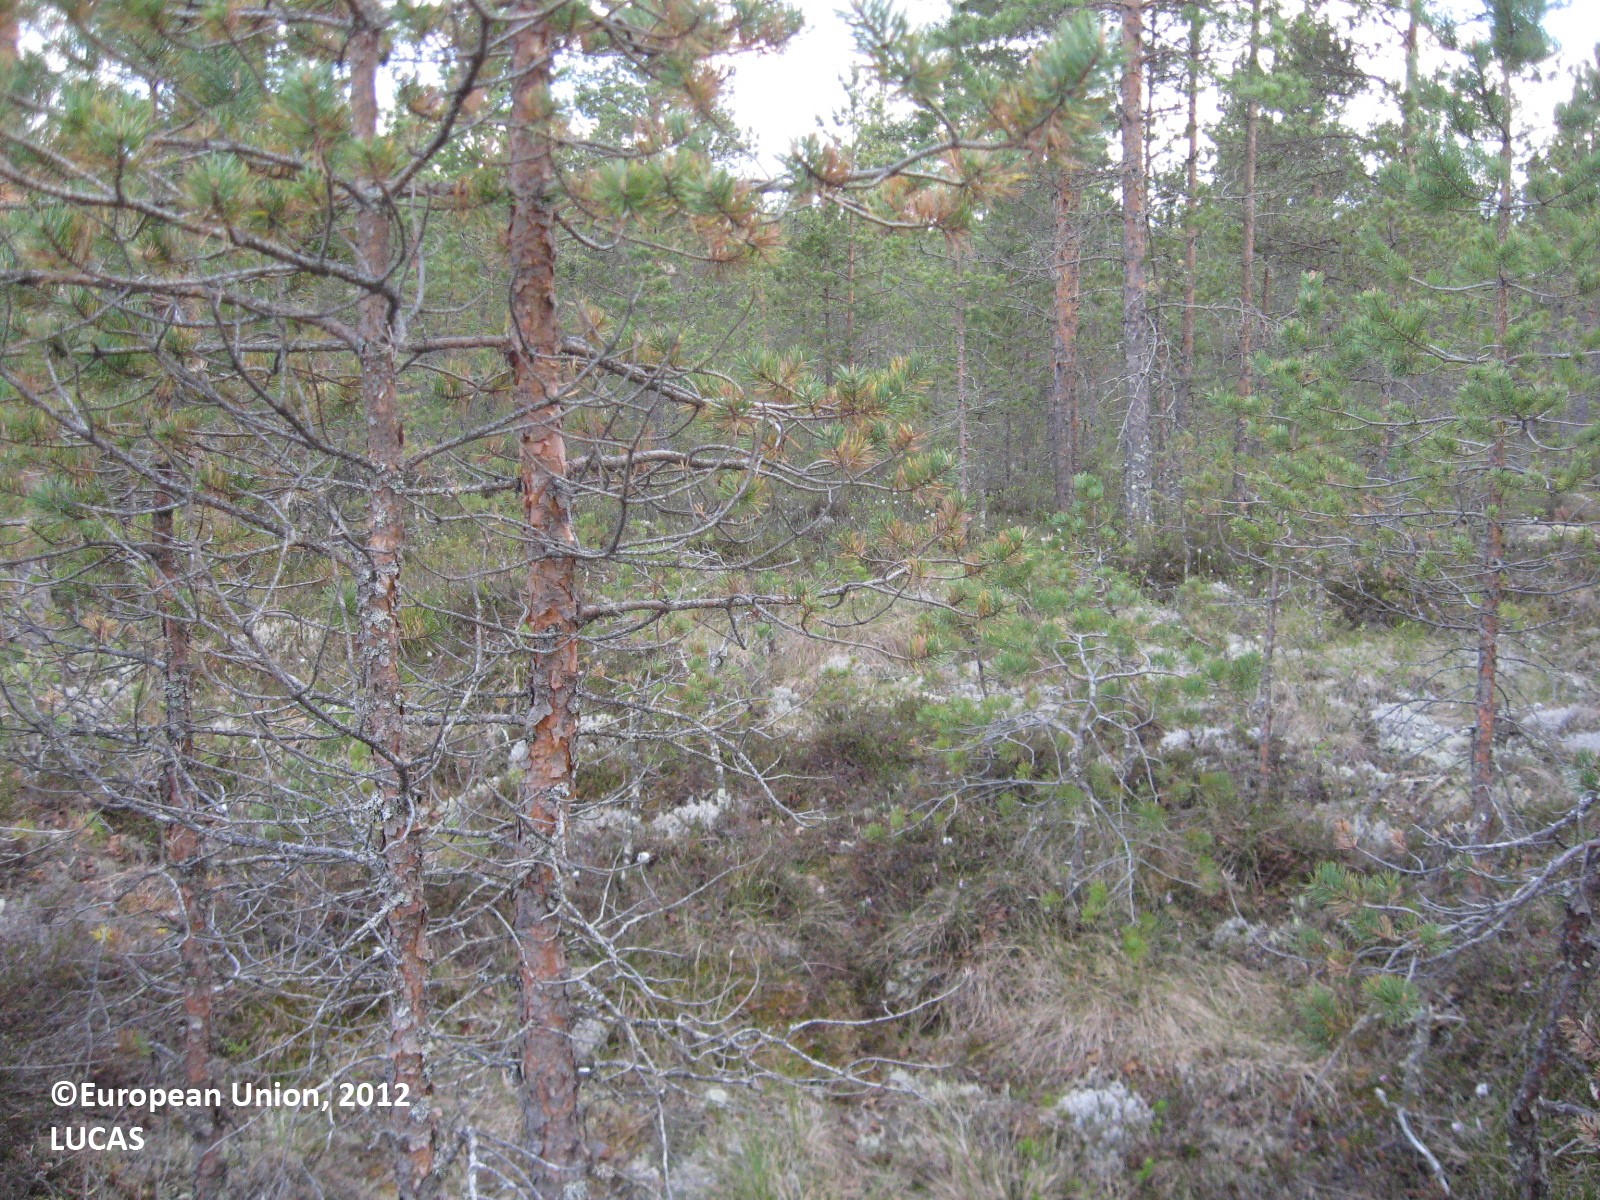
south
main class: Woodland
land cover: Pine dominated coniferous woodland
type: boreal forest
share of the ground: 50 - 75 %
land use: Forestry
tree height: < 5 m
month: June
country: FI
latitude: 63.4534
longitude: 22.8273
